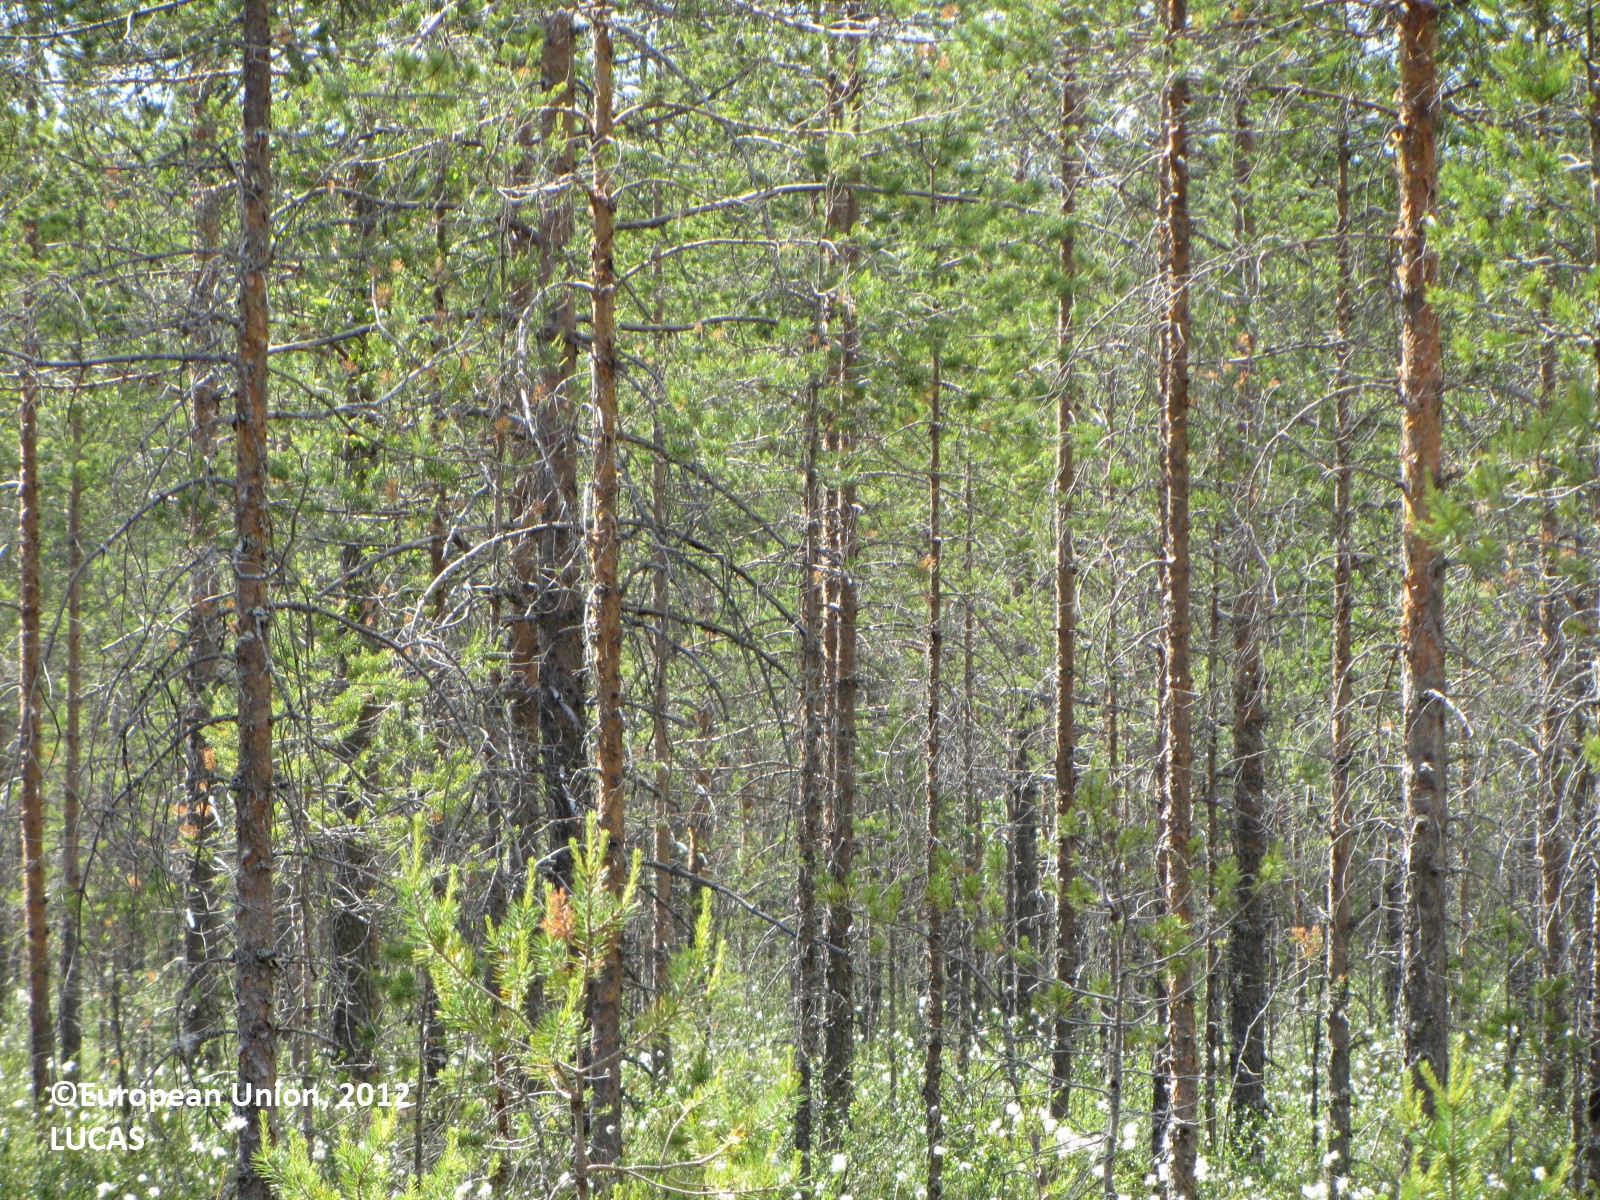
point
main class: Woodland
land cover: Pine dominated coniferous woodland
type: boreal forest
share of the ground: 50 - 75 %
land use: Forestry
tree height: > 5 m
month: July
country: FI
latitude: 63.2582
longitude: 25.3388
